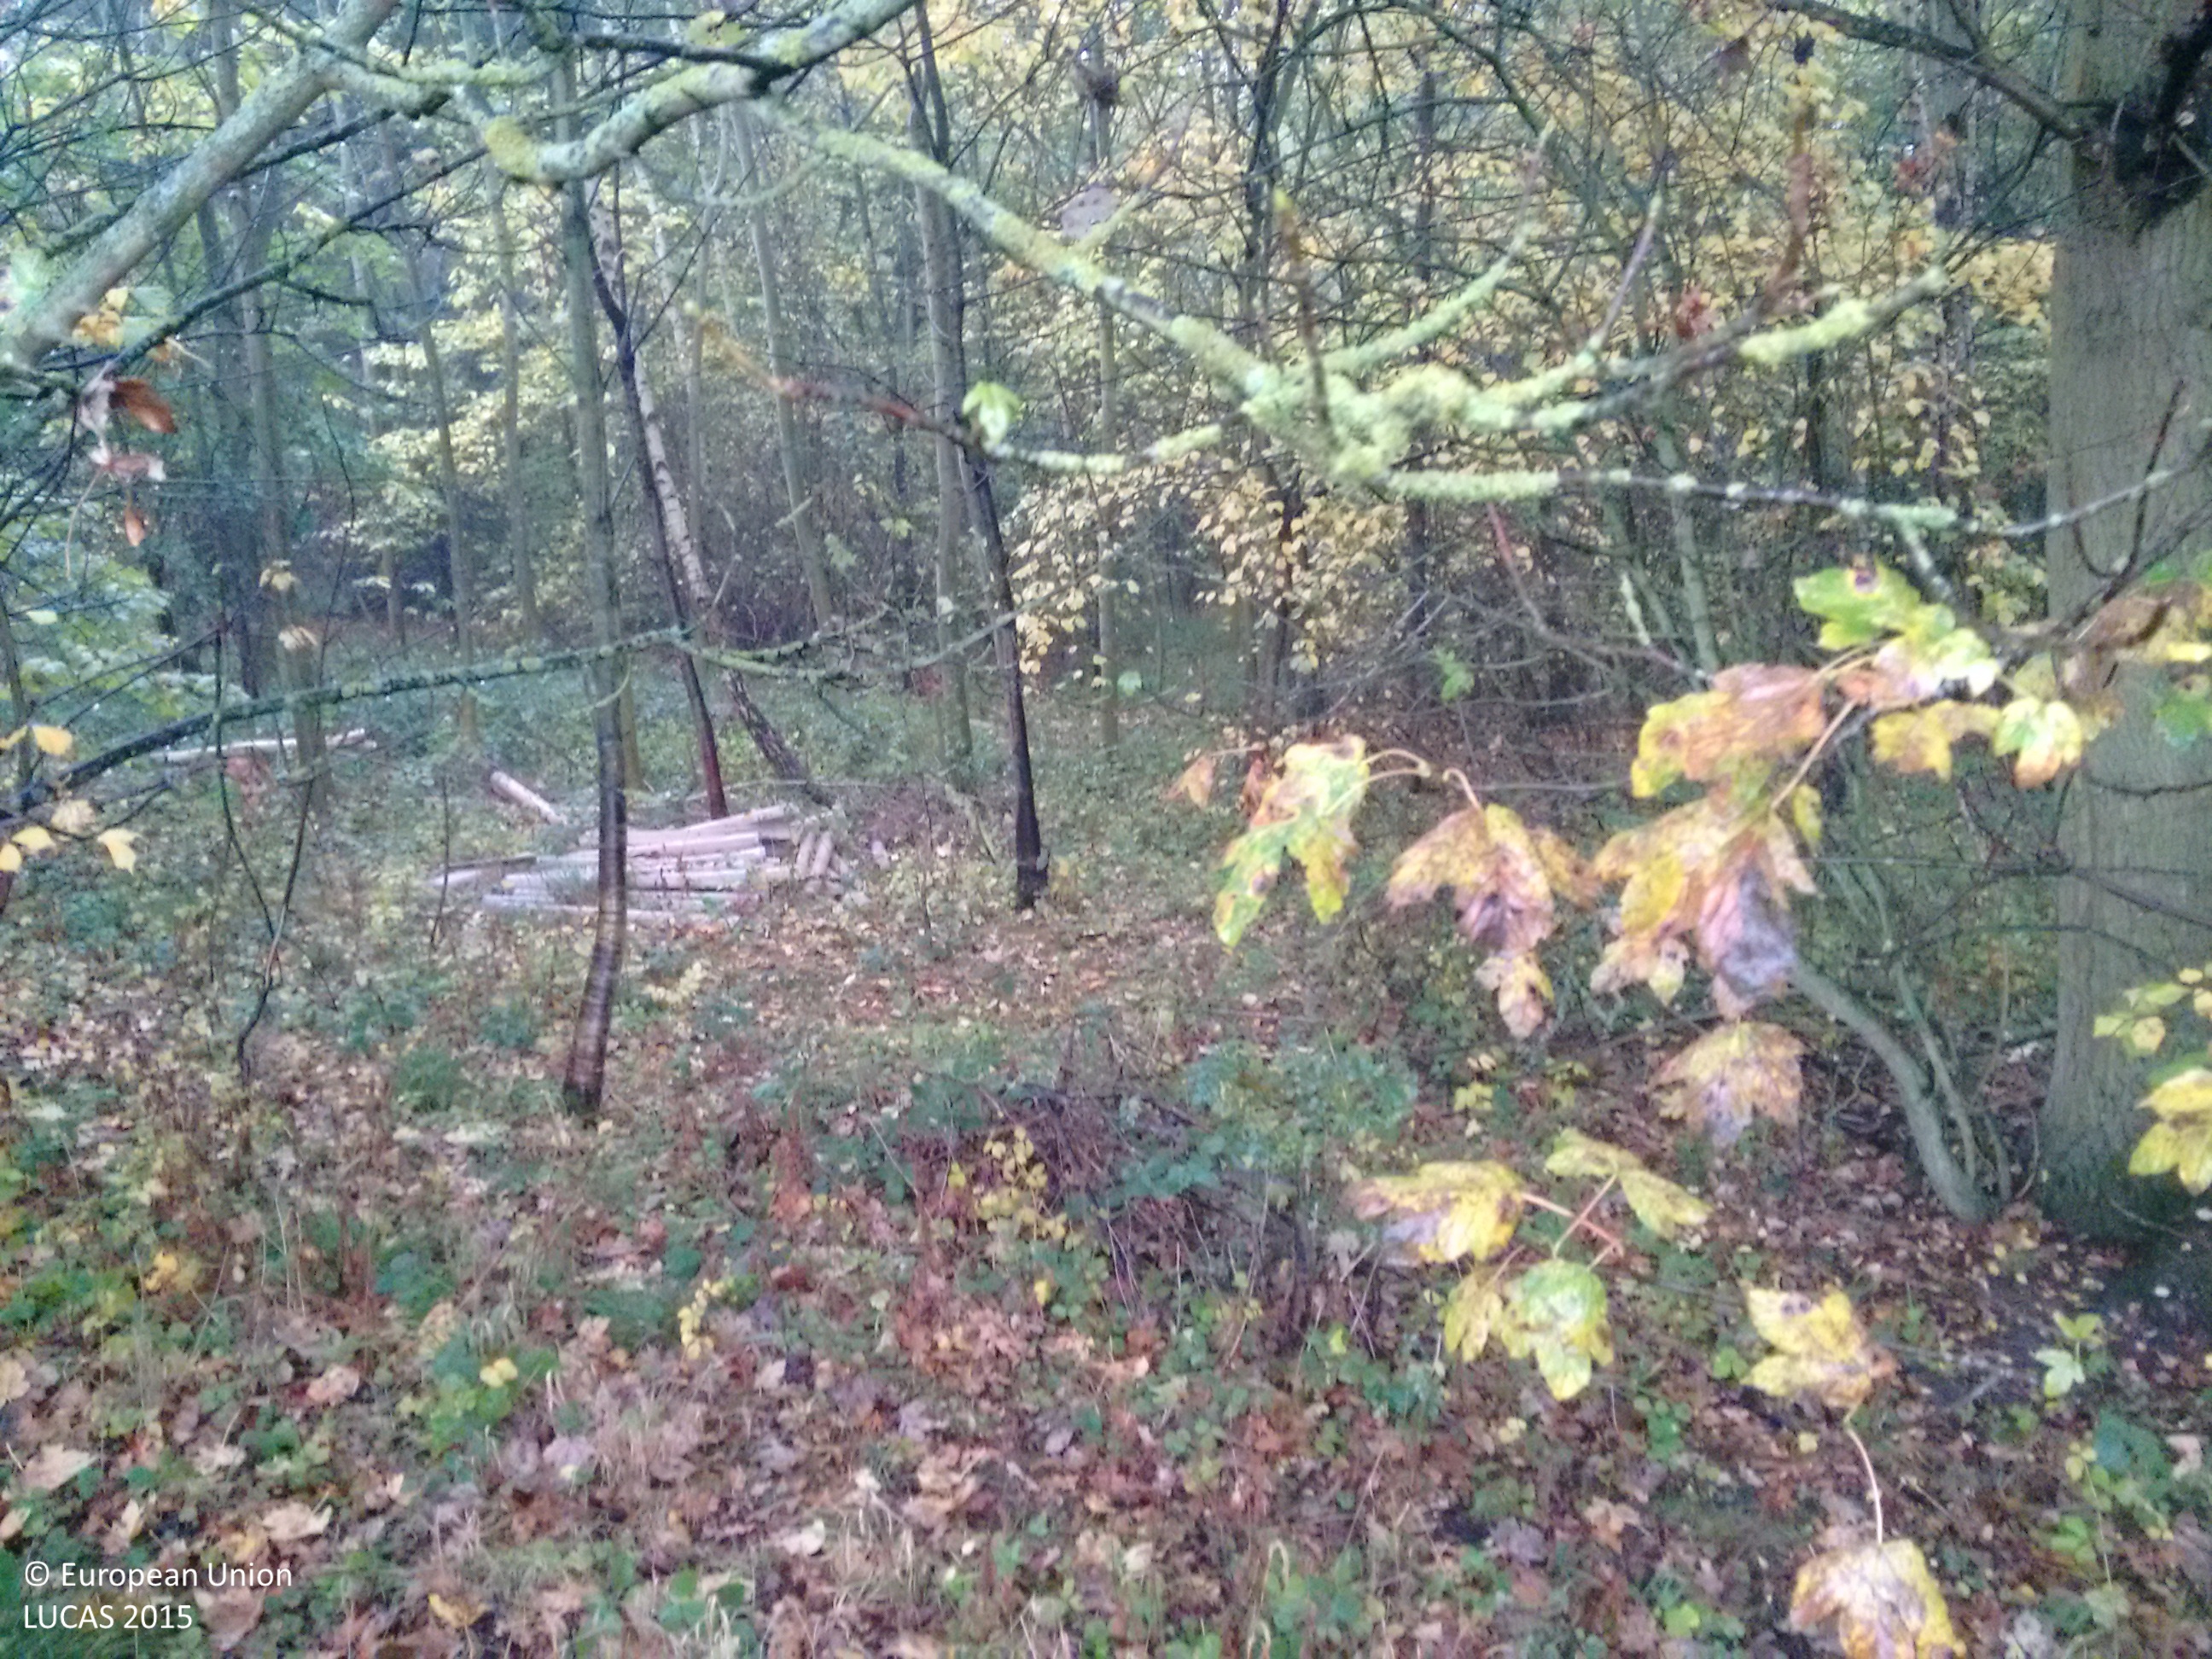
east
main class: Cropland
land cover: Common wheat
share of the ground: < 10 %
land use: Agriculture (excluding fallow land and kitchen gardens)
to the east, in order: Common wheat; Grass margins; Fences; Grass margins; Fences; Broadleaved woodland; Rivers and streams; Broadleaved woodland
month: October
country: GB
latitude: 54.5324
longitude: -1.4055
